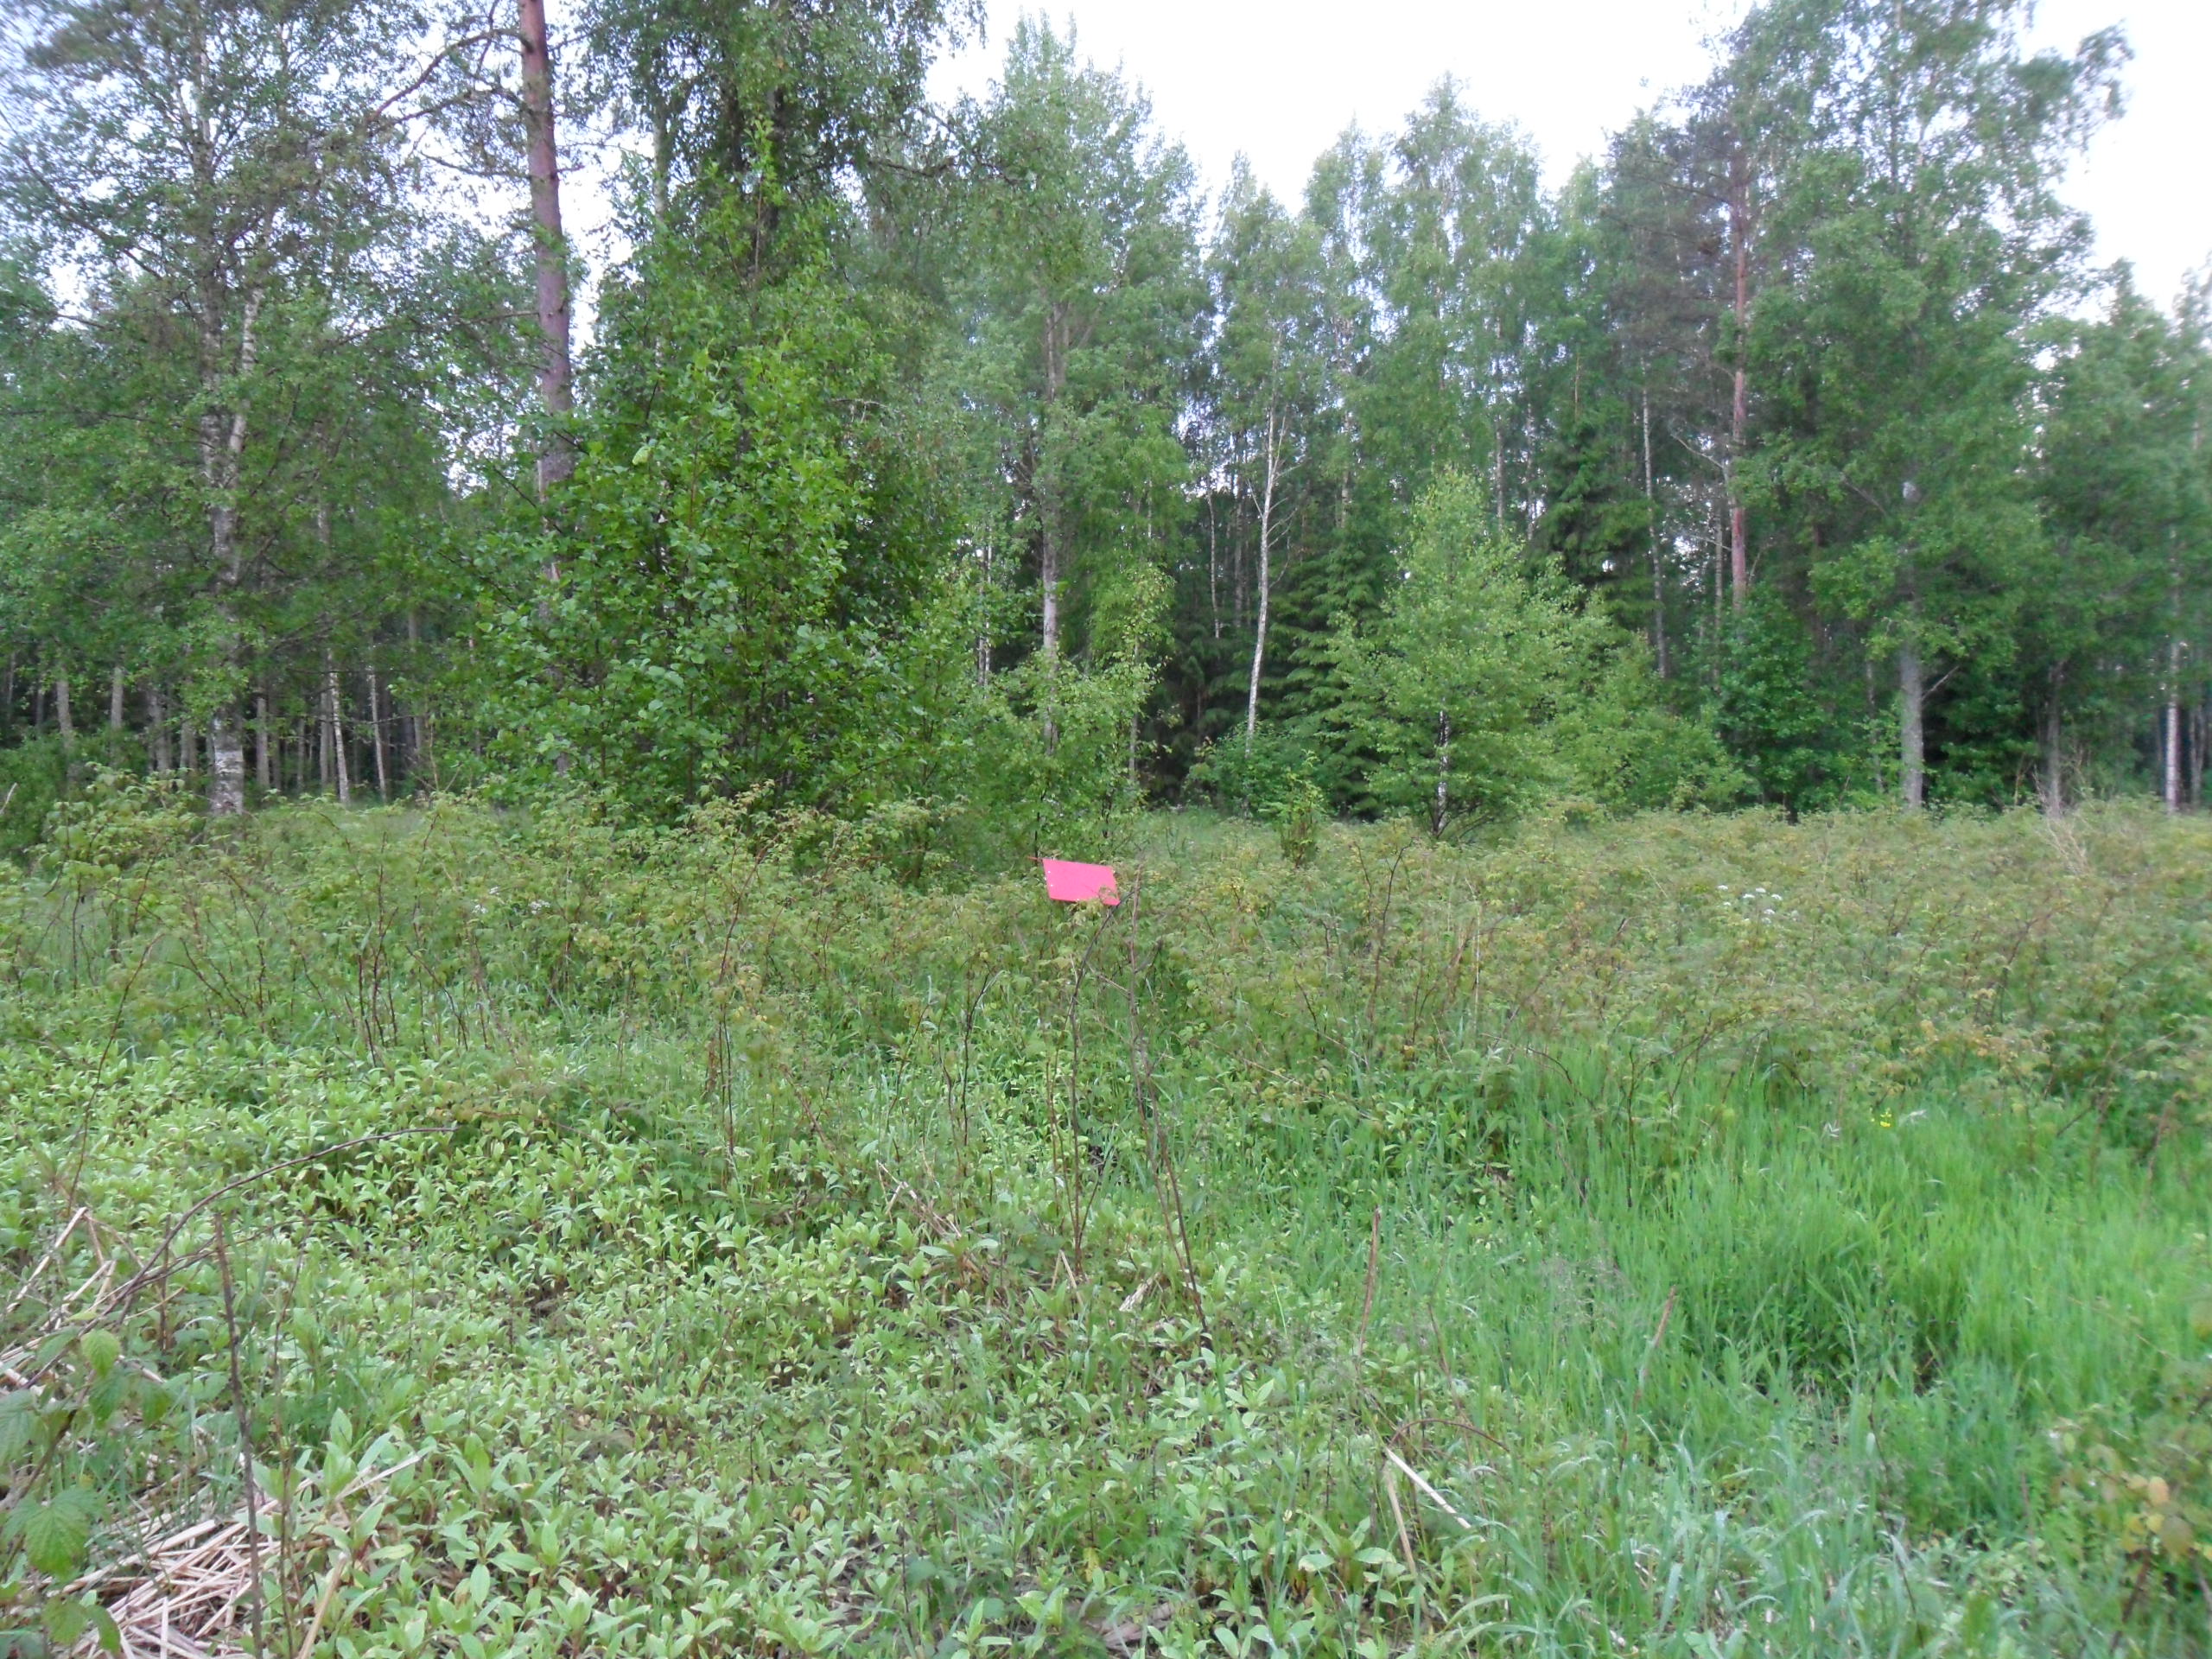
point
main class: Shrubland
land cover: Shrubland with sparse tree cover
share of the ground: > 75 %
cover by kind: shrubs 90 %, broadleaved forest trees 5 %, herbaceous plants 5 %
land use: Semi-natural and natural areas not in use
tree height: < 5 m
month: June
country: LV
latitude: 57.5026
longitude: 21.9430
